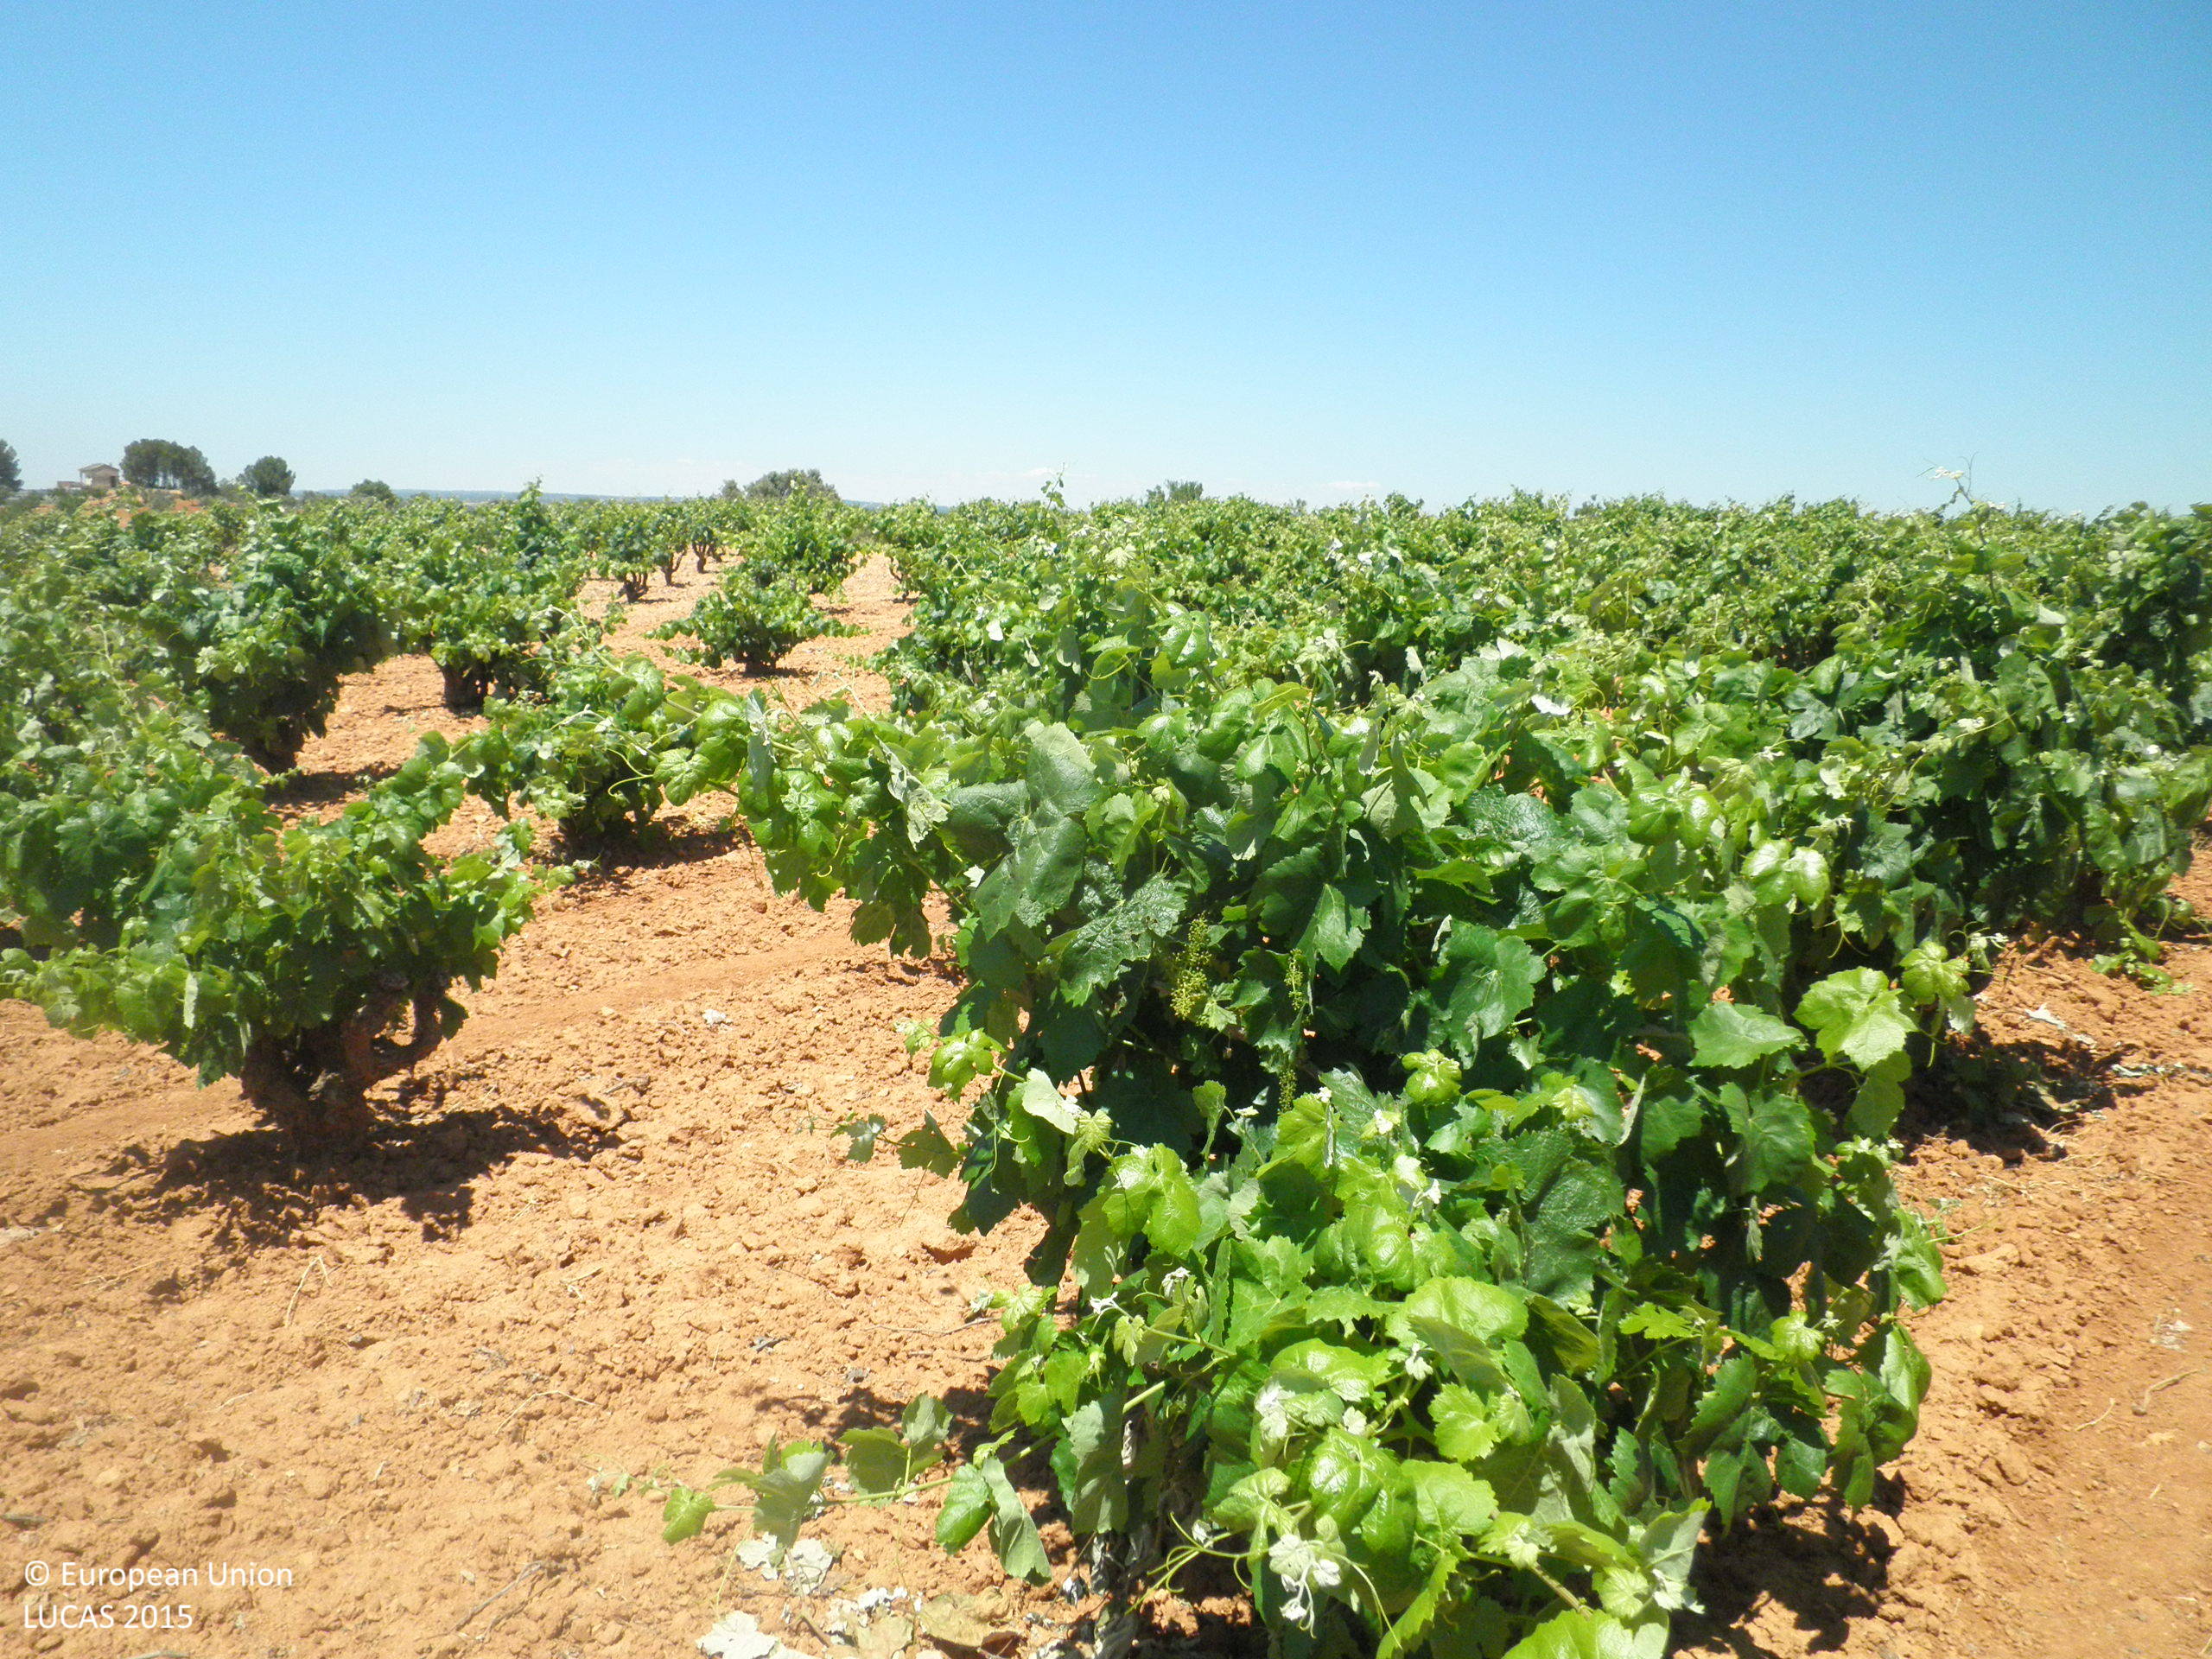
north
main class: Cropland
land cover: Vineyards
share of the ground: 10 - 25 %
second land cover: Other bare soil
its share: > 75 %
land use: Agriculture (excluding fallow land and kitchen gardens)
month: June
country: ES
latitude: 39.4749
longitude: -1.6879
